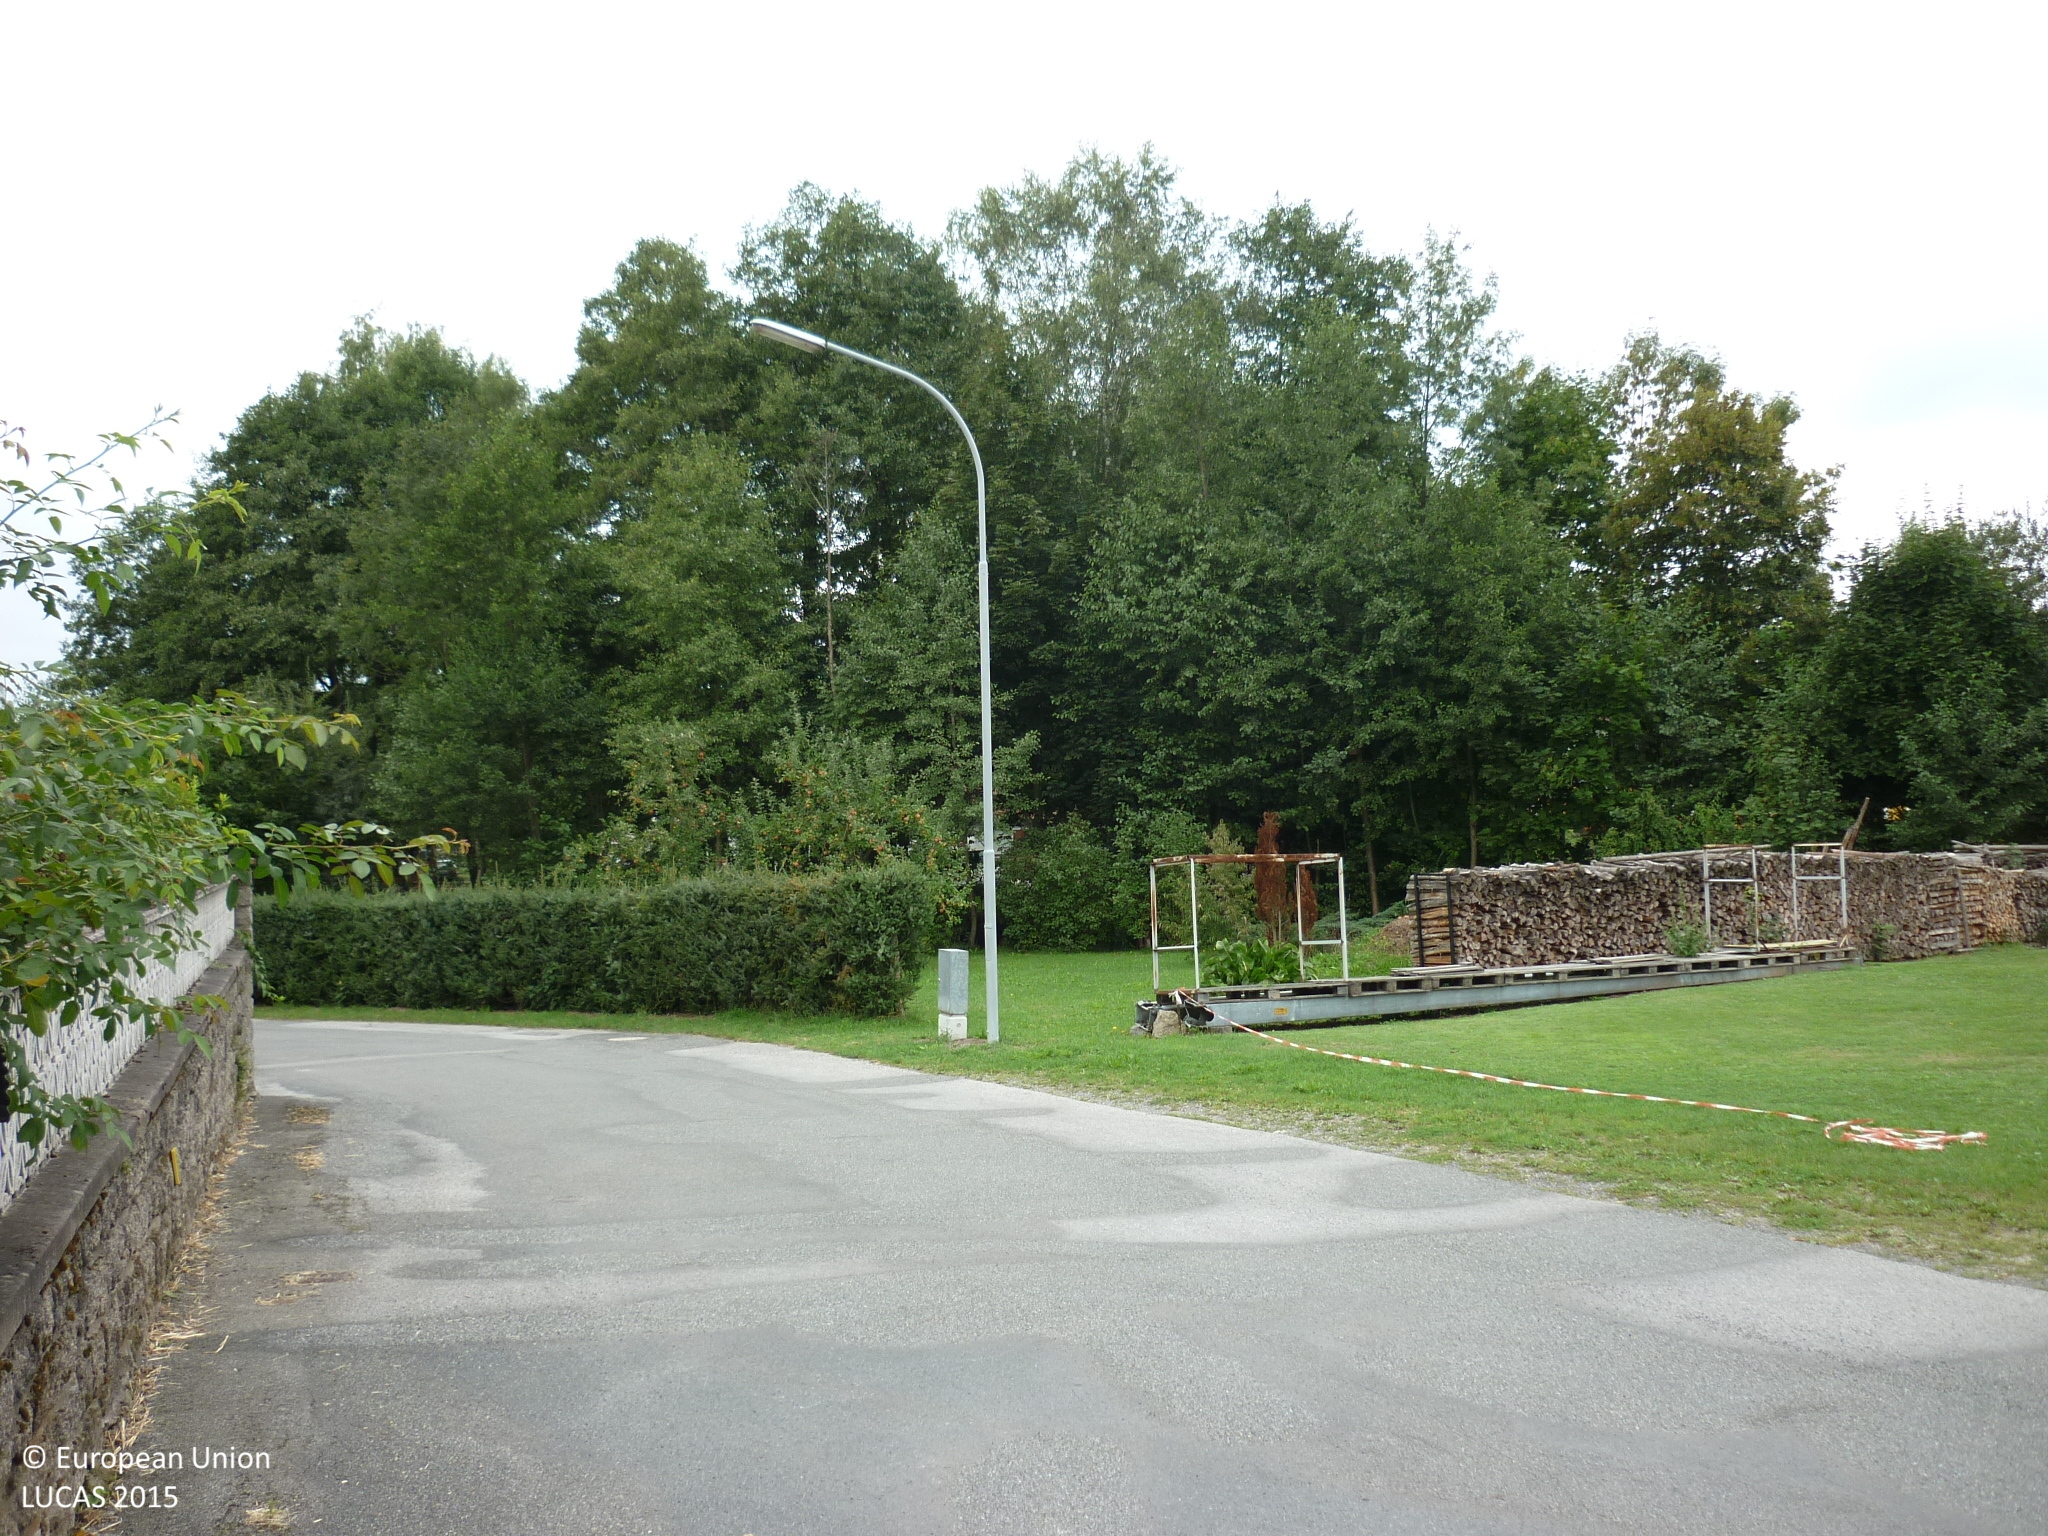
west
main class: Woodland
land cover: Other mixed woodland
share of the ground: > 75 %
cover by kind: coniferous forest trees 50 %, broadleaved forest trees 50 %
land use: Residential
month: September
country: AT
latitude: 48.8621
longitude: 15.1139
